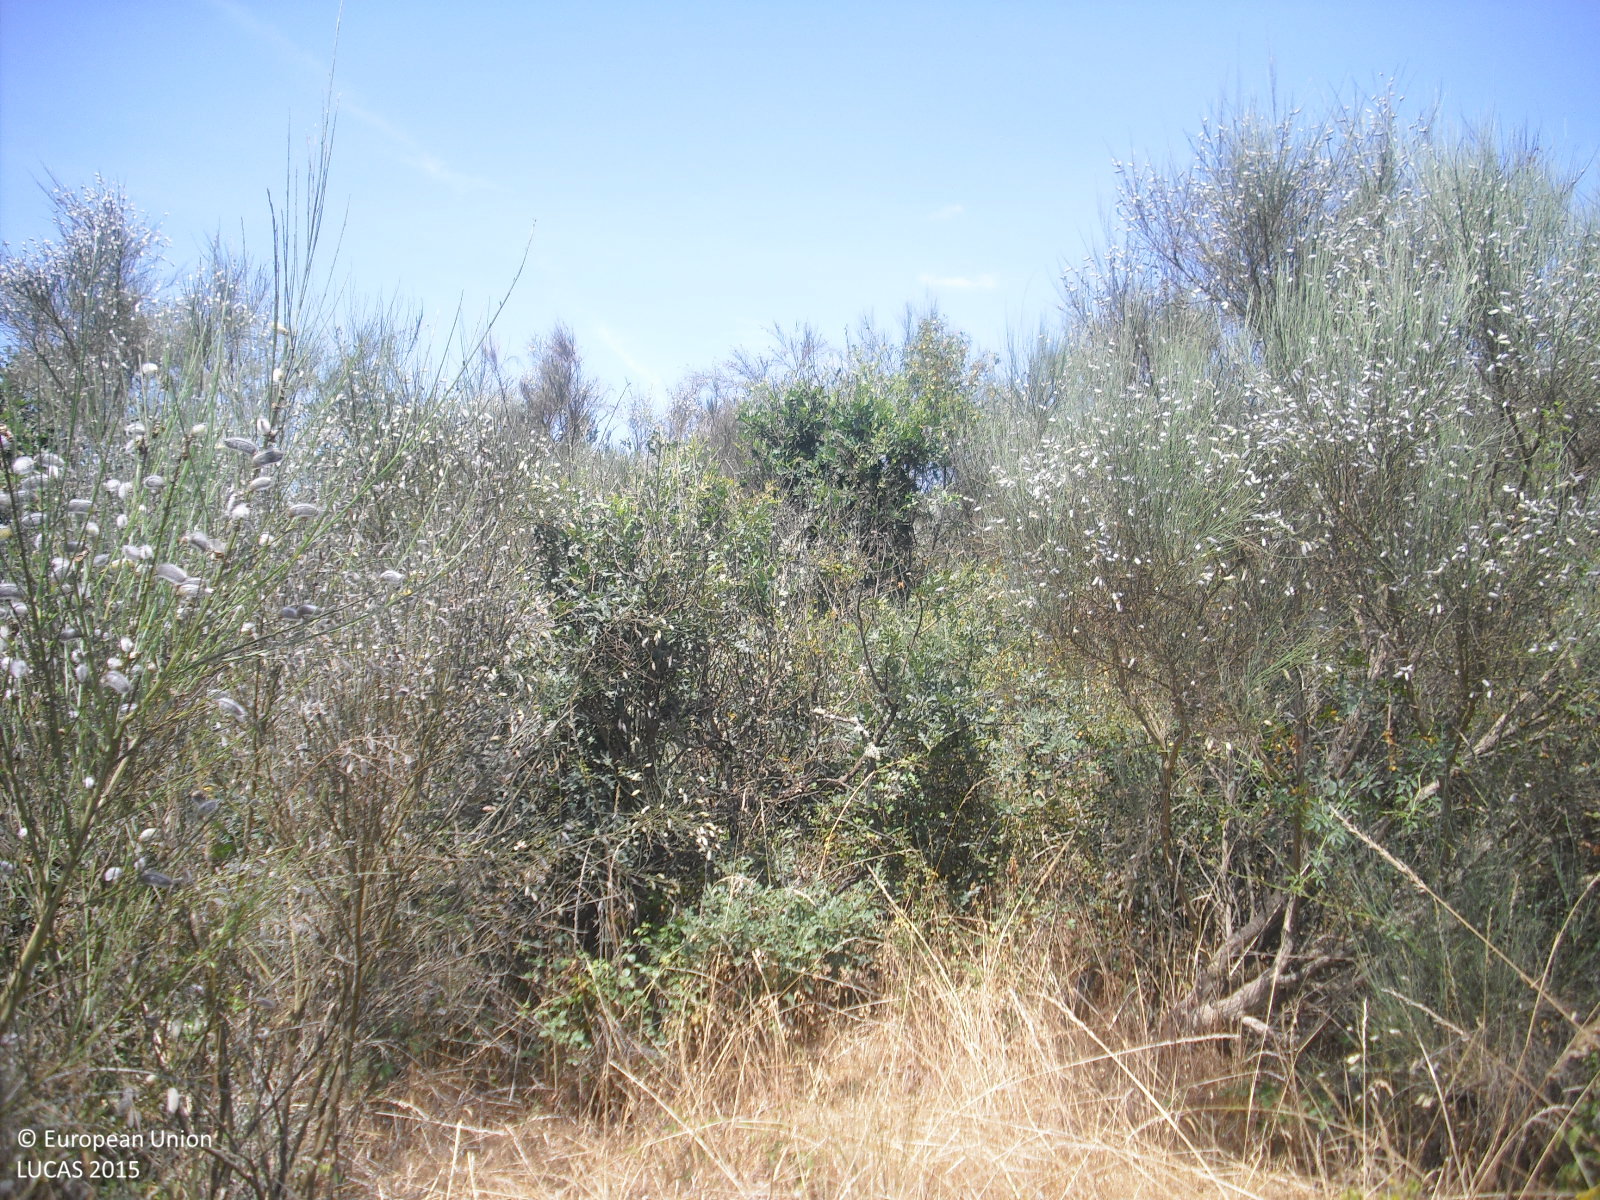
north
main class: Shrubland
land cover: Shrubland without tree cover
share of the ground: 50 - 75 %
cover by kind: shrubs 70 %, herbaceous plants 30 %
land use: Abandoned areas
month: July
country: ES
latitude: 42.4979
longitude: -7.5062
